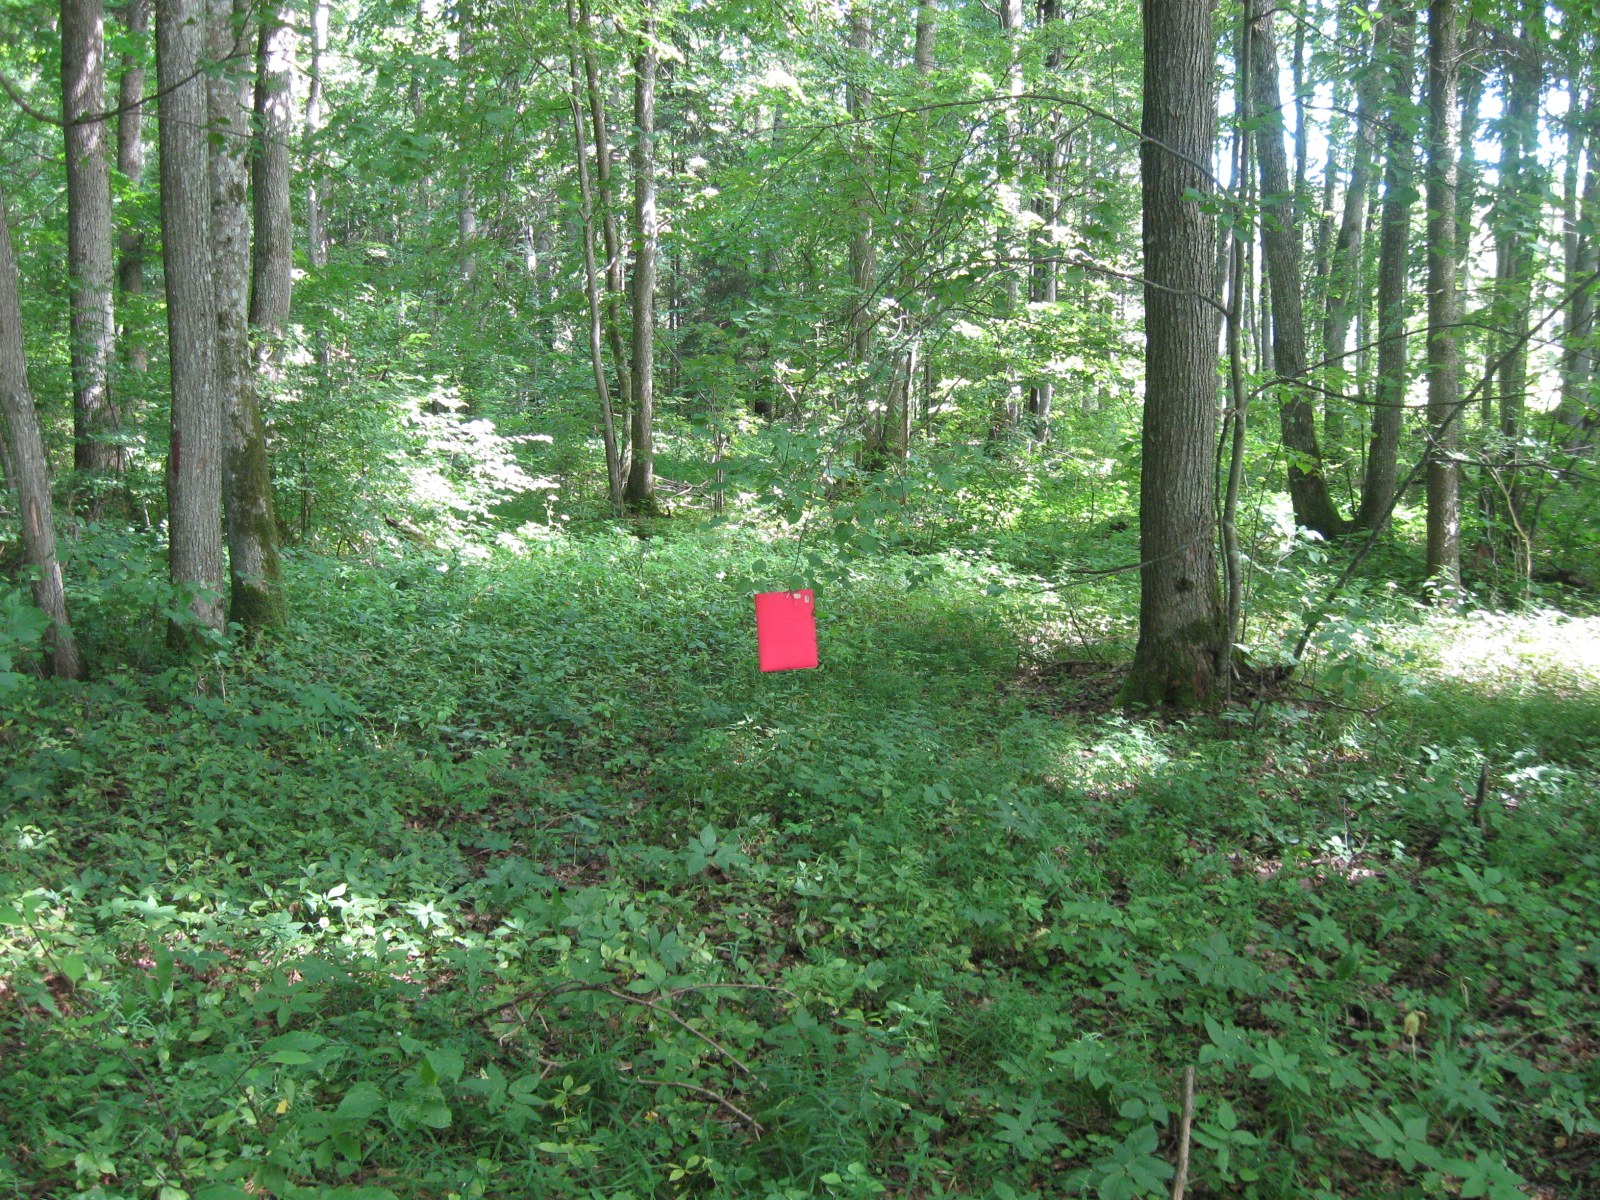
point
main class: Woodland
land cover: Other mixed woodland
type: hemiboreal forest and nemoral coniferous forest and mixed broadleaved-coniferous forest
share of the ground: > 75 %
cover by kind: broadleaved forest trees 65 %, coniferous forest trees 30 %, herbaceous plants 5 %
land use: Forestry
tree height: > 5 m
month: July
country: LT
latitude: 54.9742
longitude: 23.6921
